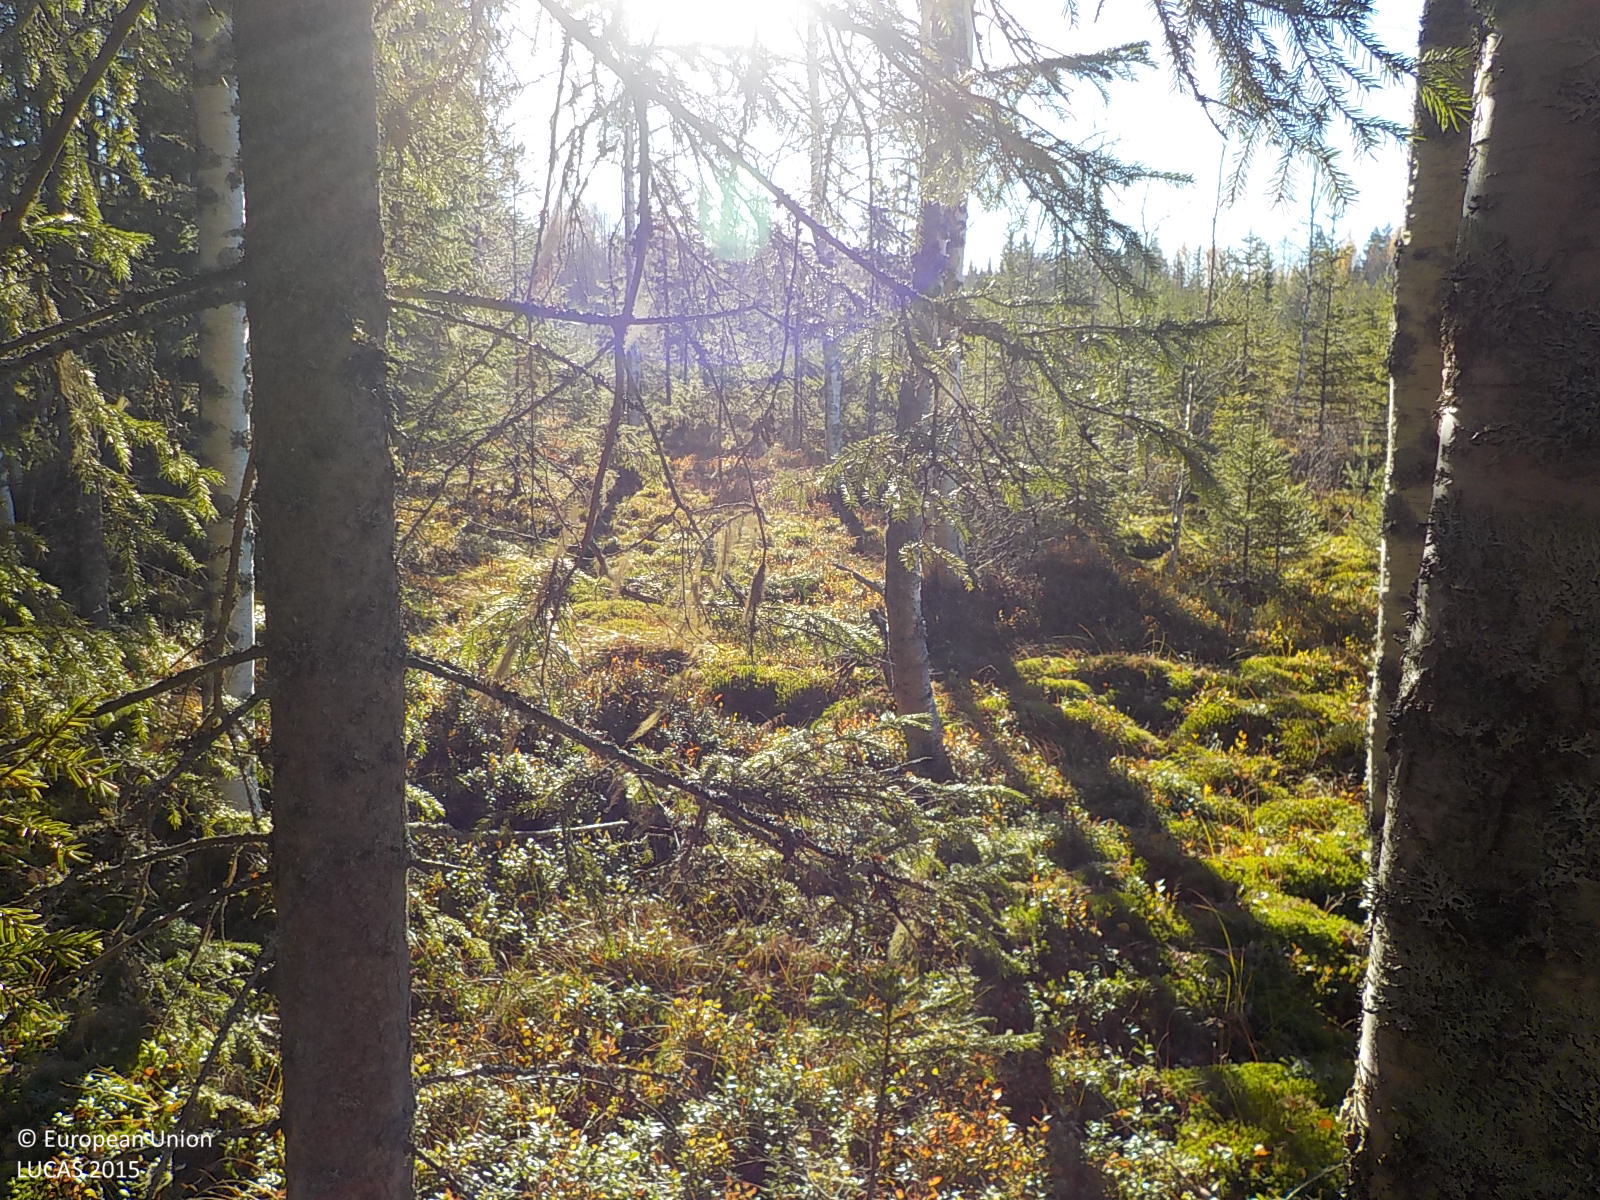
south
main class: Woodland
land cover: Spruce dominated mixed woodland
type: boreal forest
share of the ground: > 75 %
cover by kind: coniferous forest trees 50 %, broadleaved forest trees 45 %, shrubs 5 %
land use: Forestry
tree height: > 5 m
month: October
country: SE
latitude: 63.2858
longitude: 18.0515
